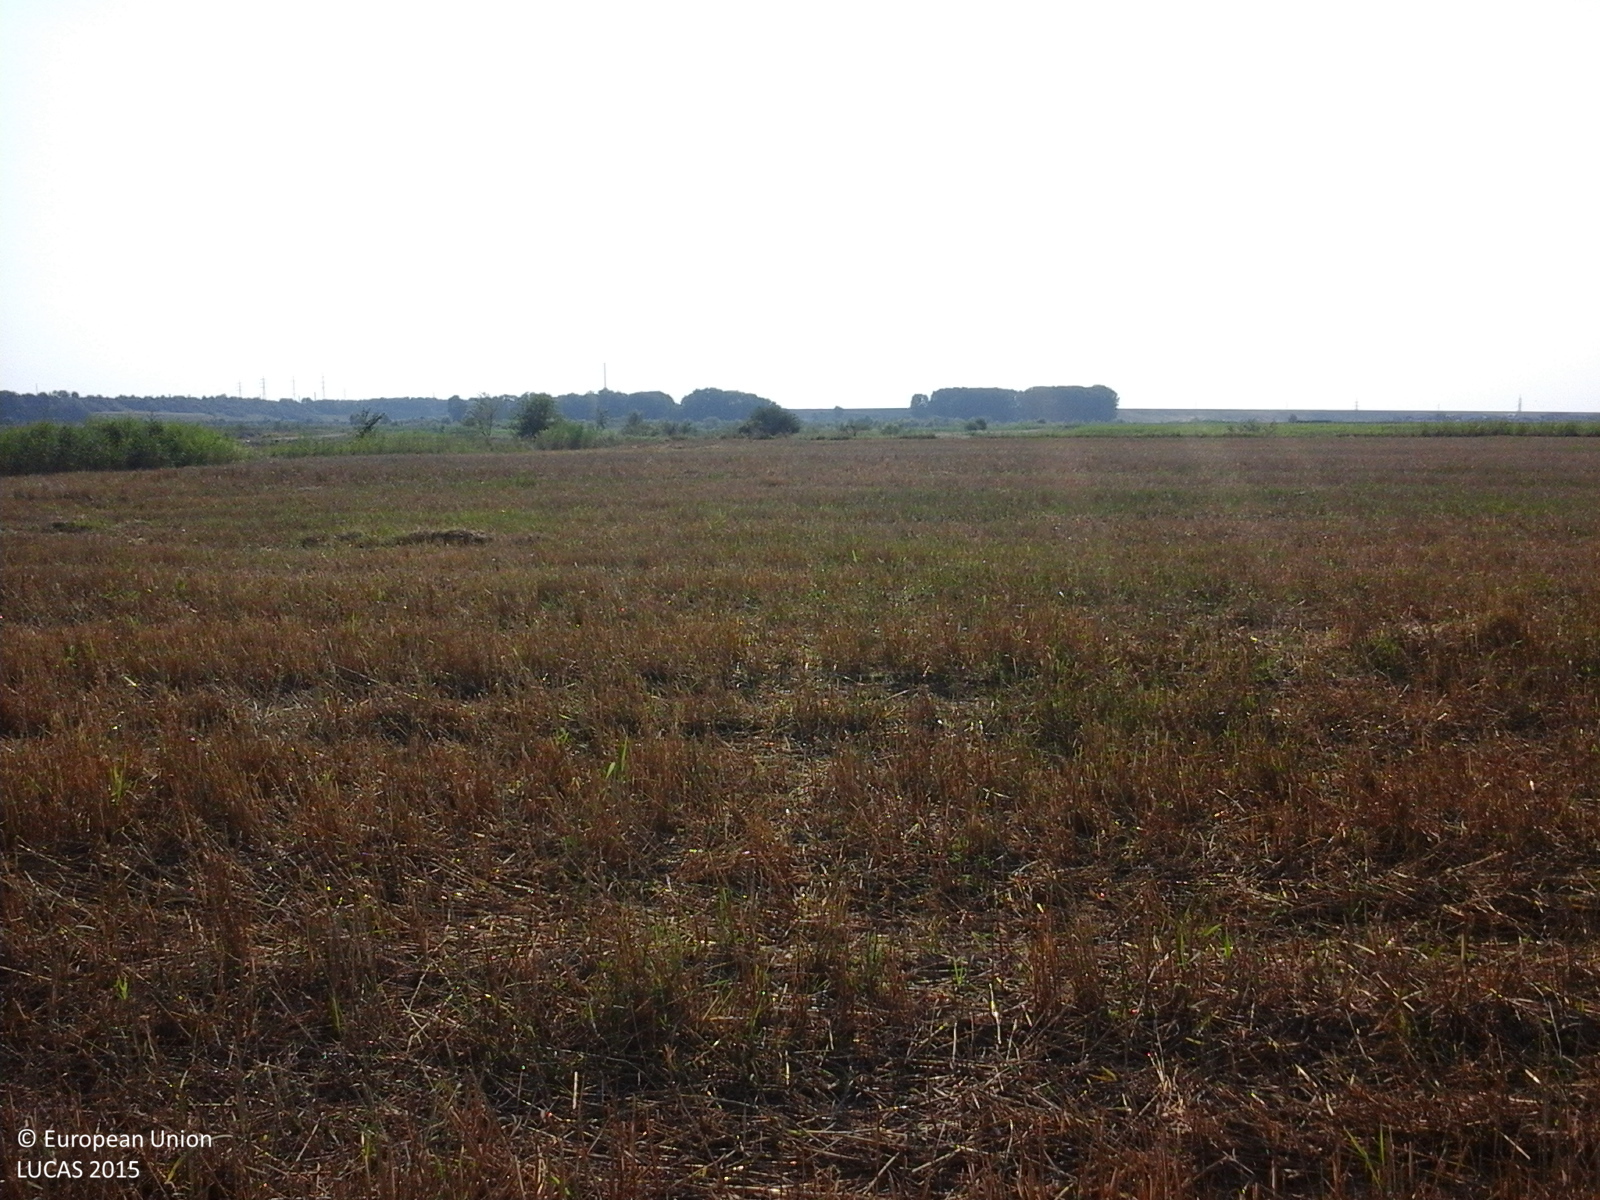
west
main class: Cropland
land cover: Common wheat
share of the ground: < 10 %
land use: Agriculture (excluding fallow land and kitchen gardens)
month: July
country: RO
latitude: 44.8075
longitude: 25.0163
